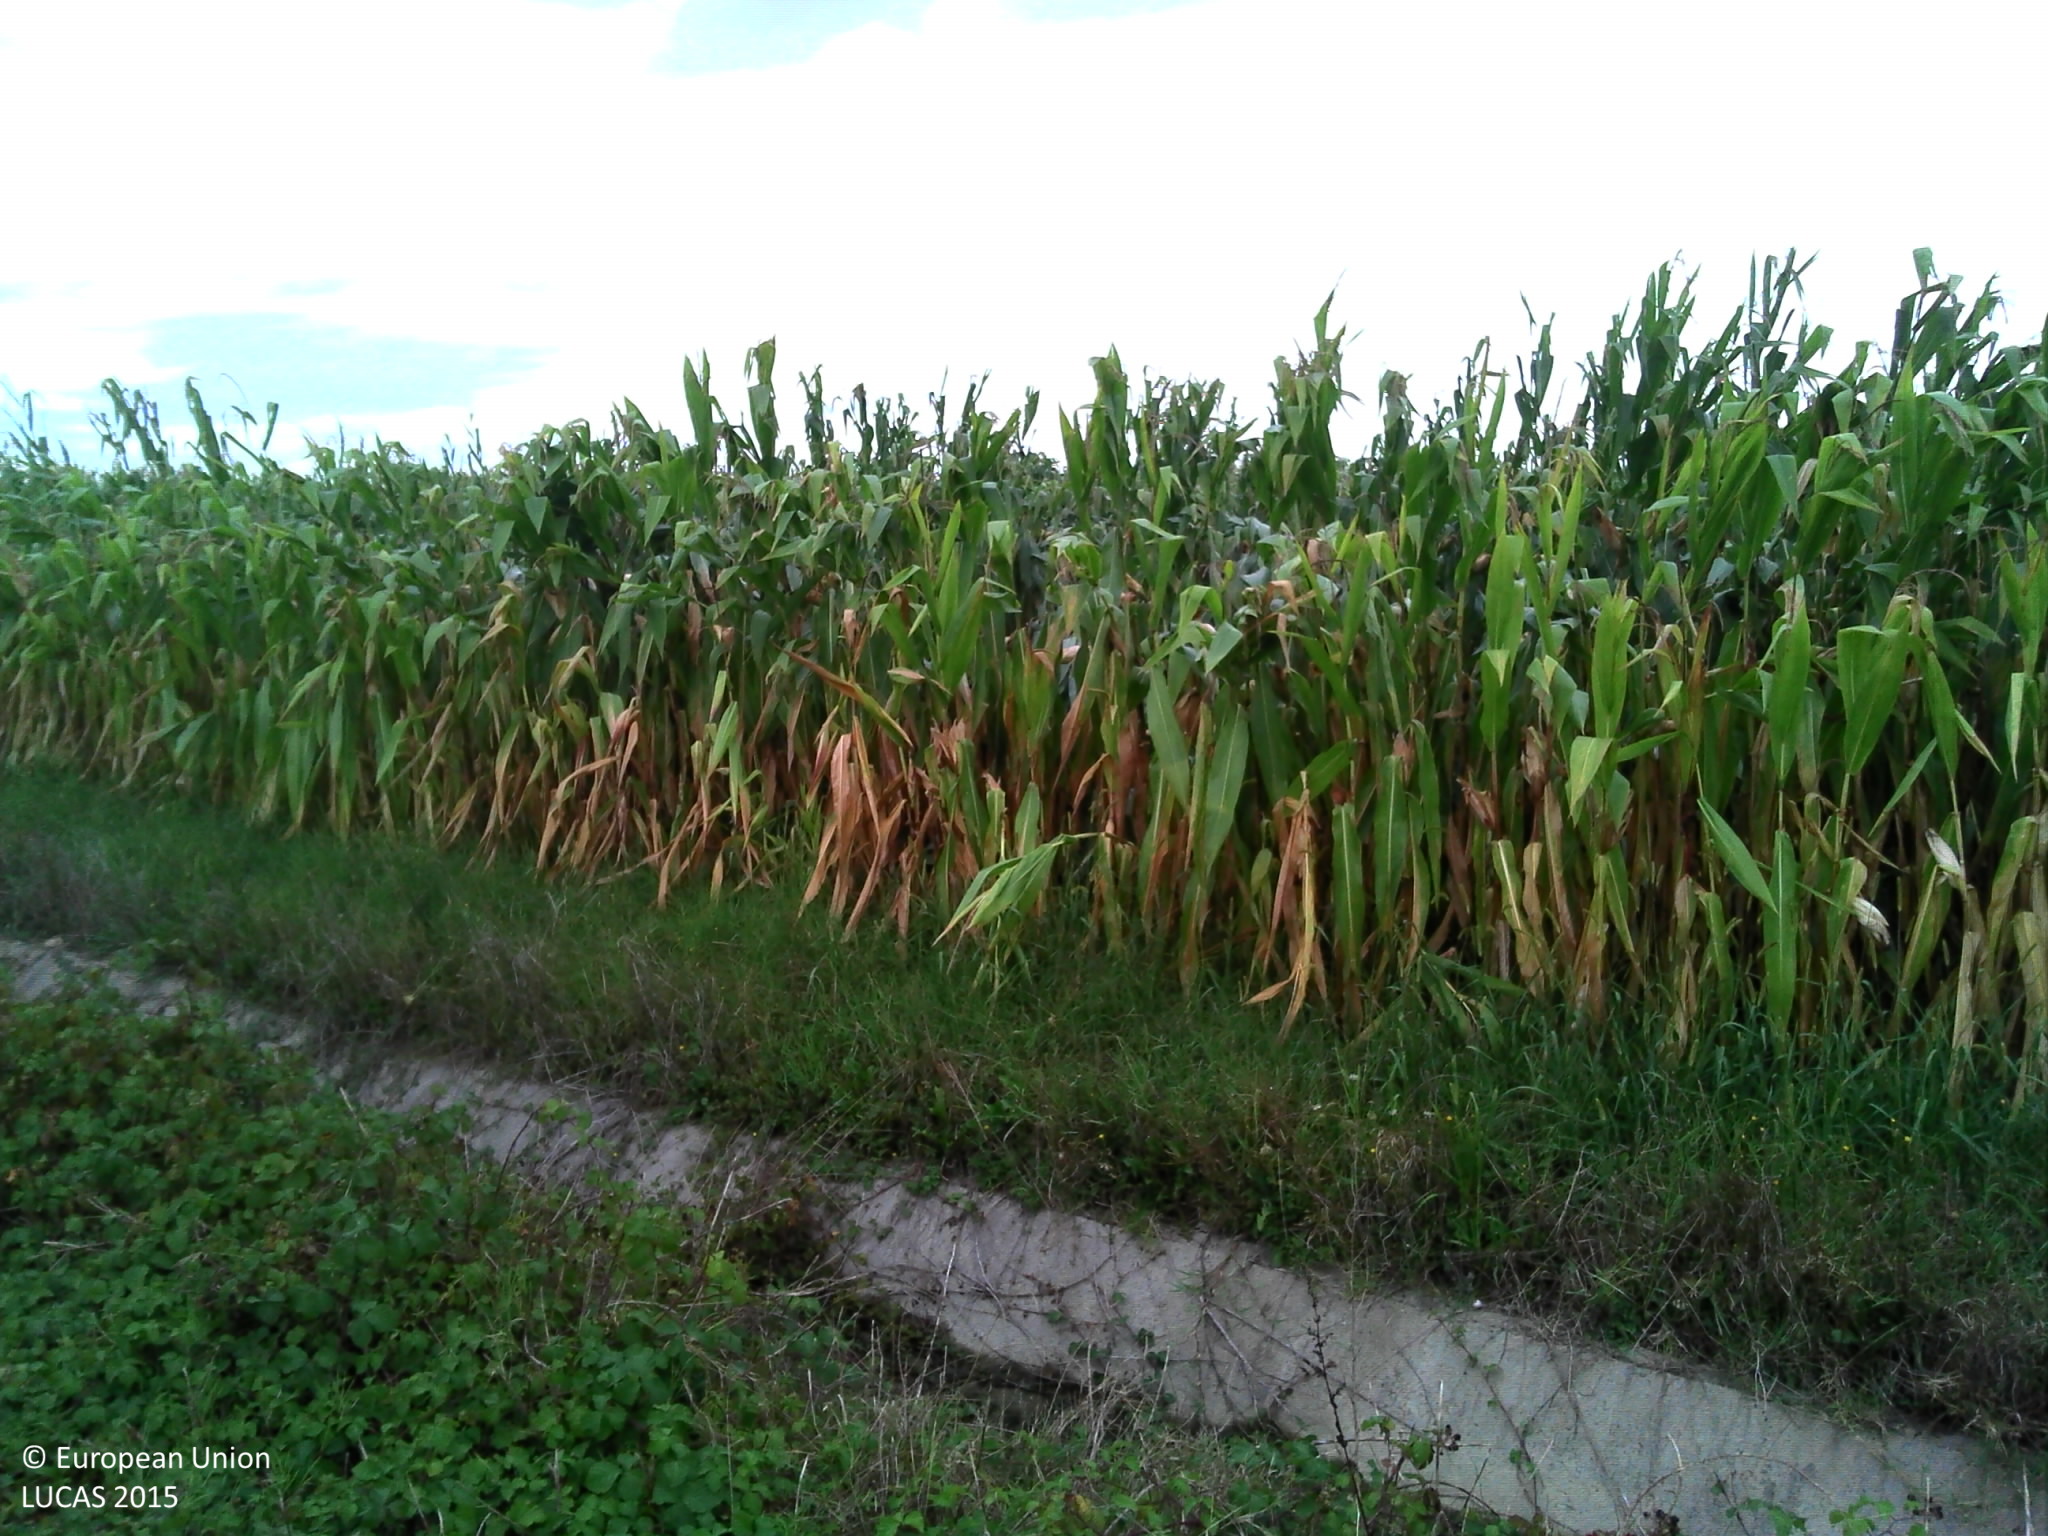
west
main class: Grassland
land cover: Grassland without tree/shrub cover
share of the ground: > 75 %
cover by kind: herbaceous plants 95 %, shrubs 5 %
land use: Road transport
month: September
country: FR
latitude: 43.4221
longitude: -0.4453
